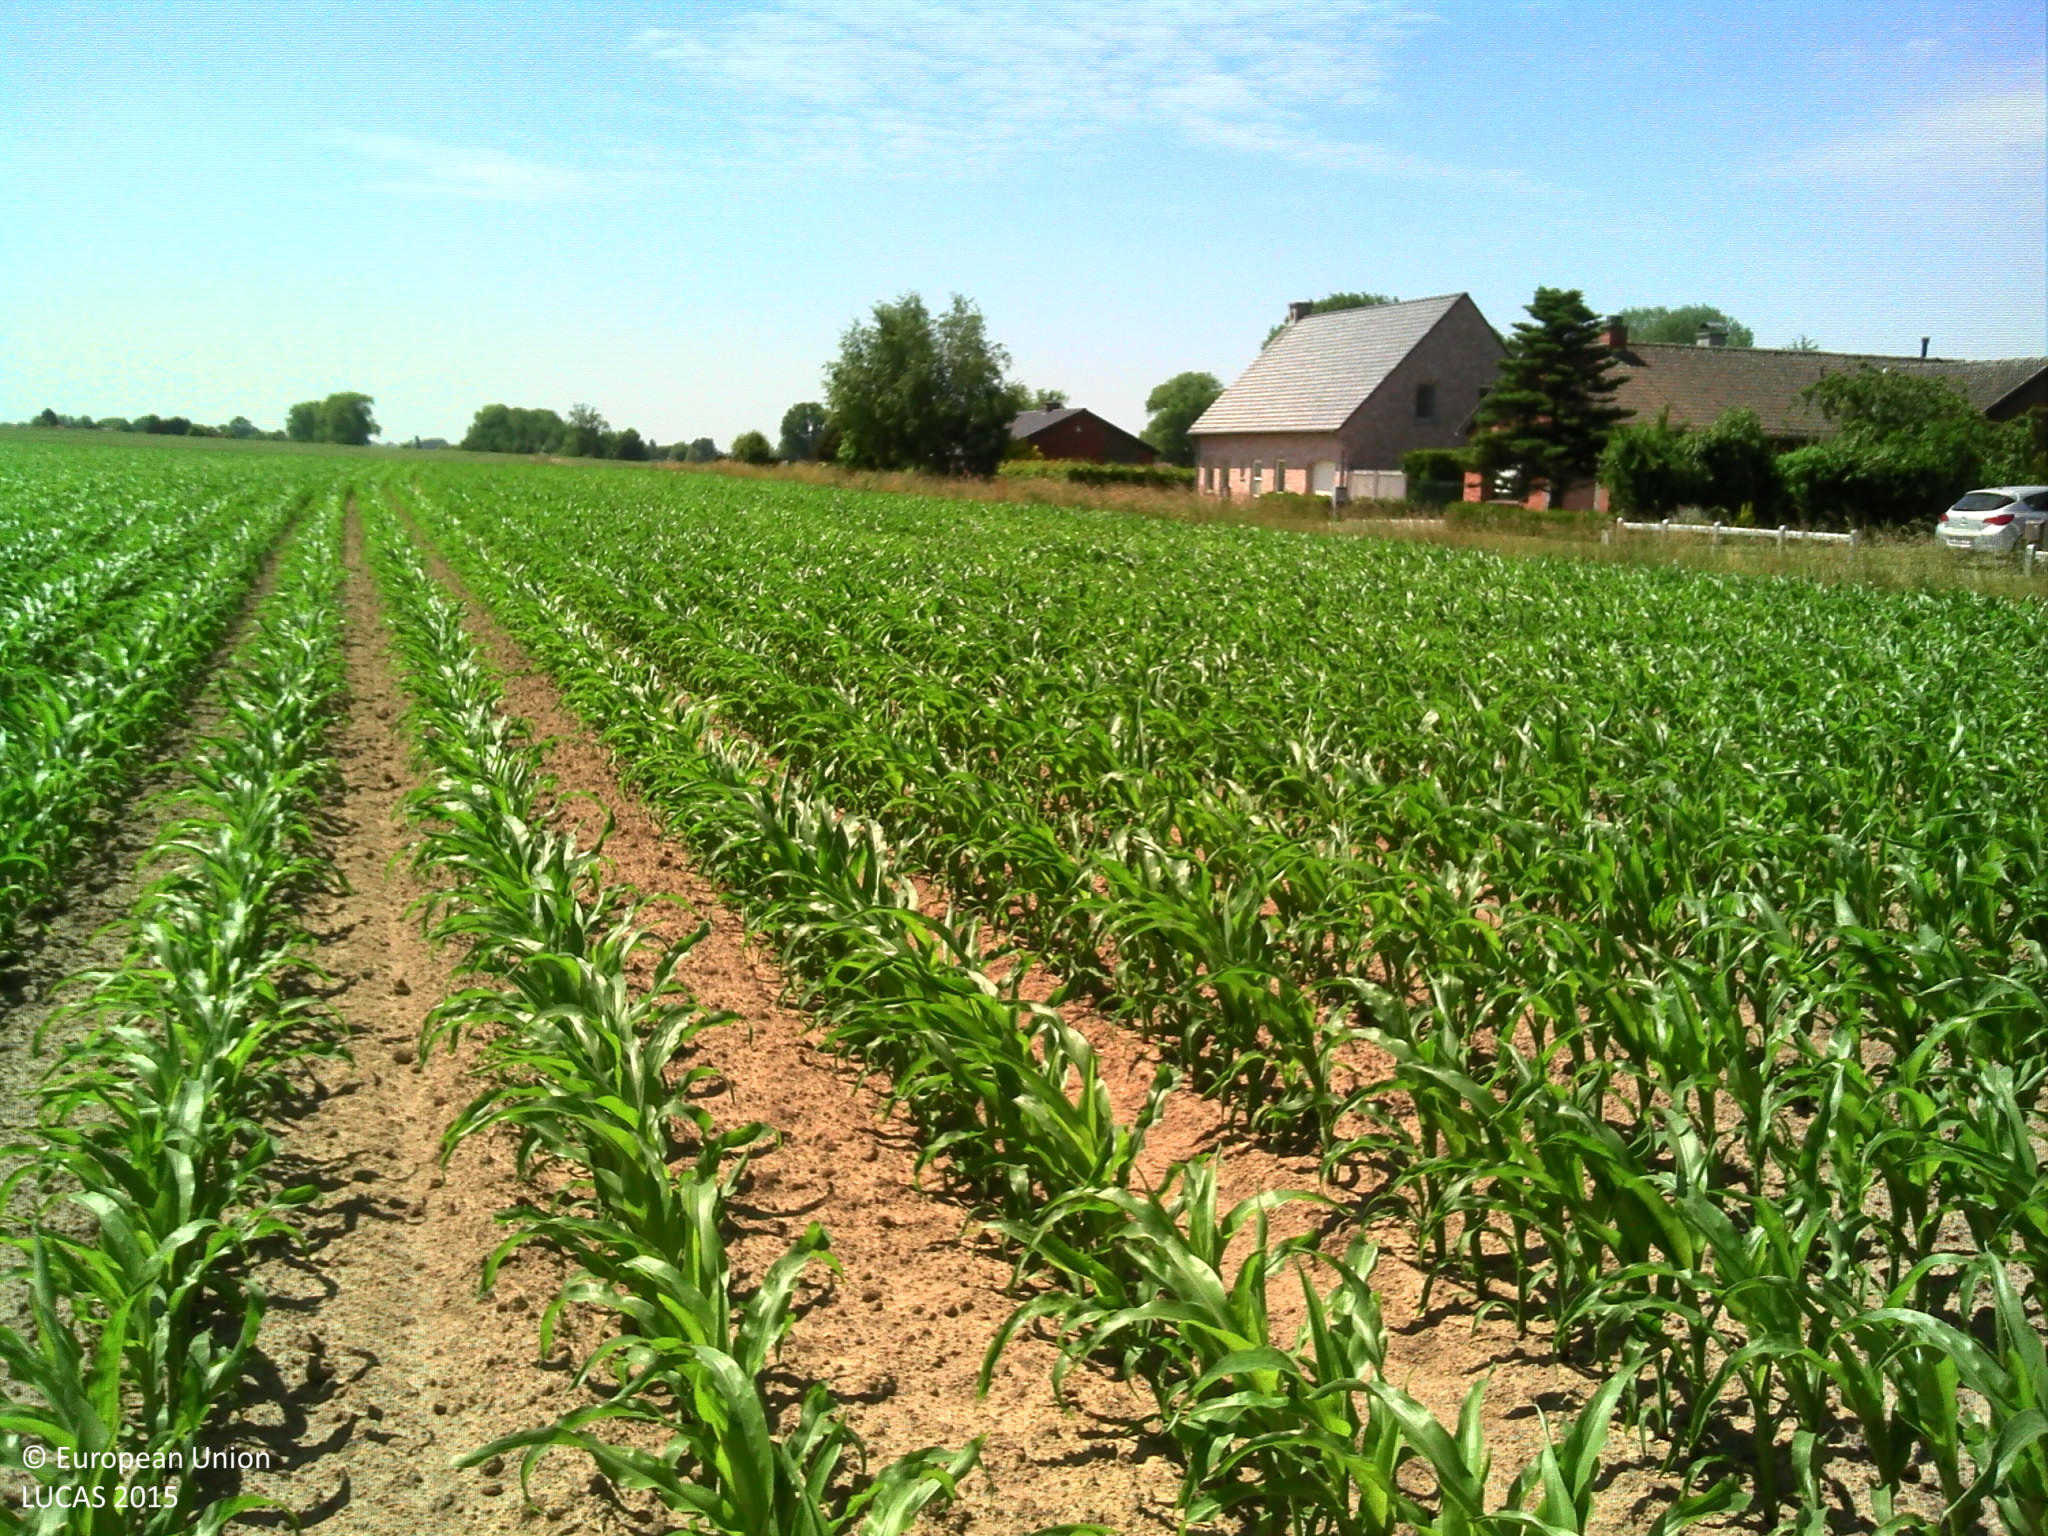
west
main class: Cropland
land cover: Maize
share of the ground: > 75 %
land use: Agriculture (excluding fallow land and kitchen gardens)
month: June
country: BE
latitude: 50.7425
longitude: 3.5730
